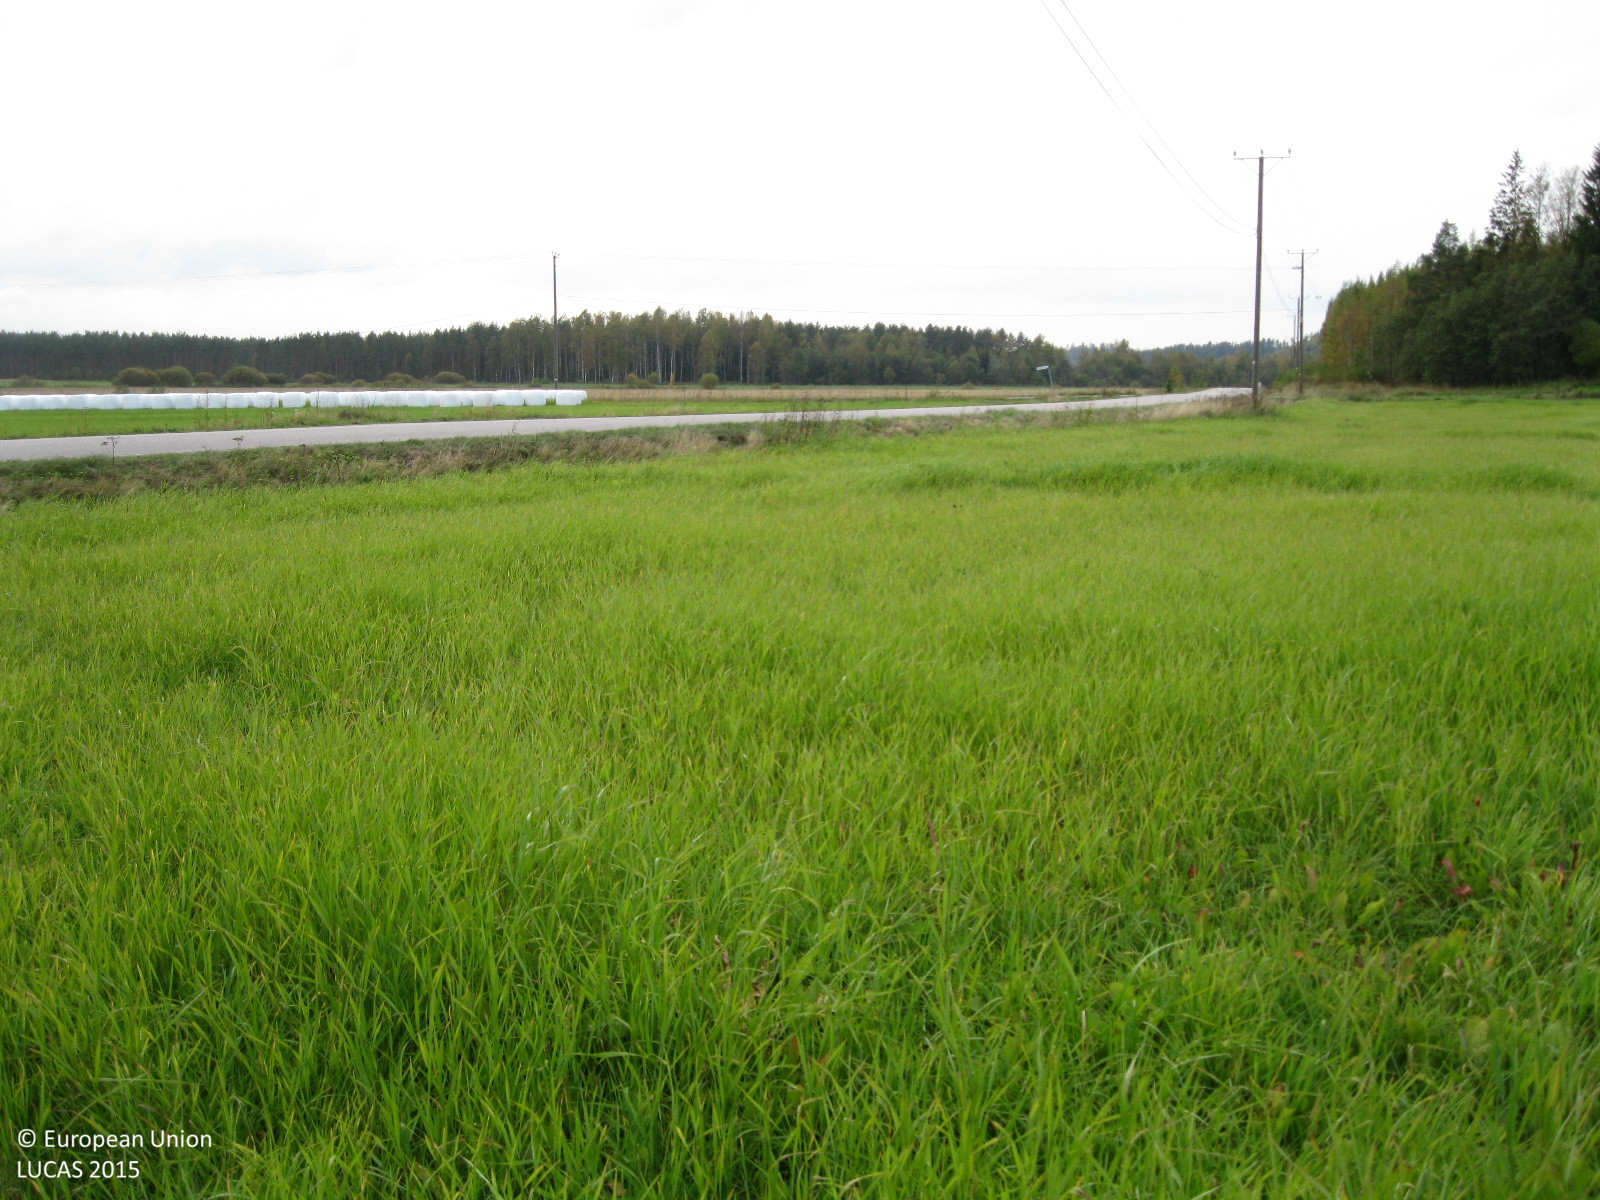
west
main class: Cropland
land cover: Temporary grasslands
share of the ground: > 75 %
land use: Agriculture (excluding fallow land and kitchen gardens)
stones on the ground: < 10 %
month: September
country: FI
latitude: 60.5842
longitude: 24.6566
